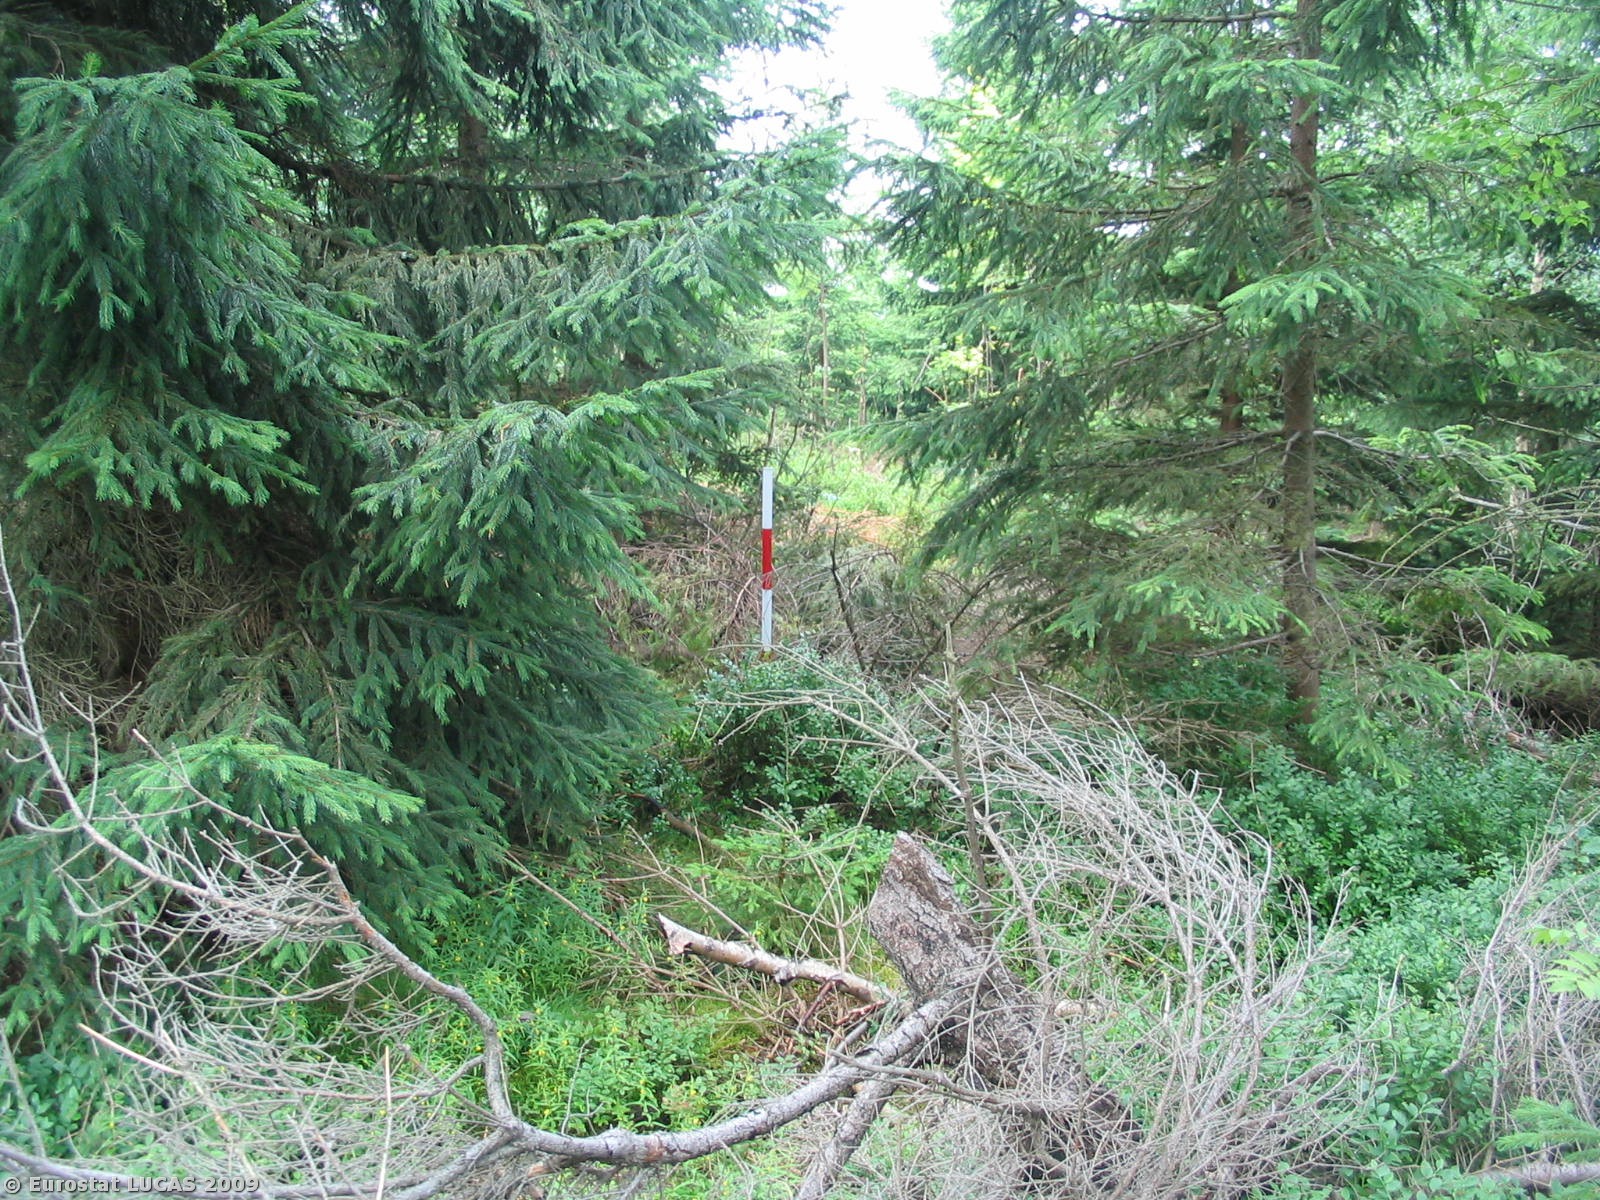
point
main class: Woodland
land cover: Mixed woodland
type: mountainous beech forest
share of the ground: > 75 %
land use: Forestry
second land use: Nature reserves
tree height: > 5 m
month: July
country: CZ
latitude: 50.7010
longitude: 15.8529
